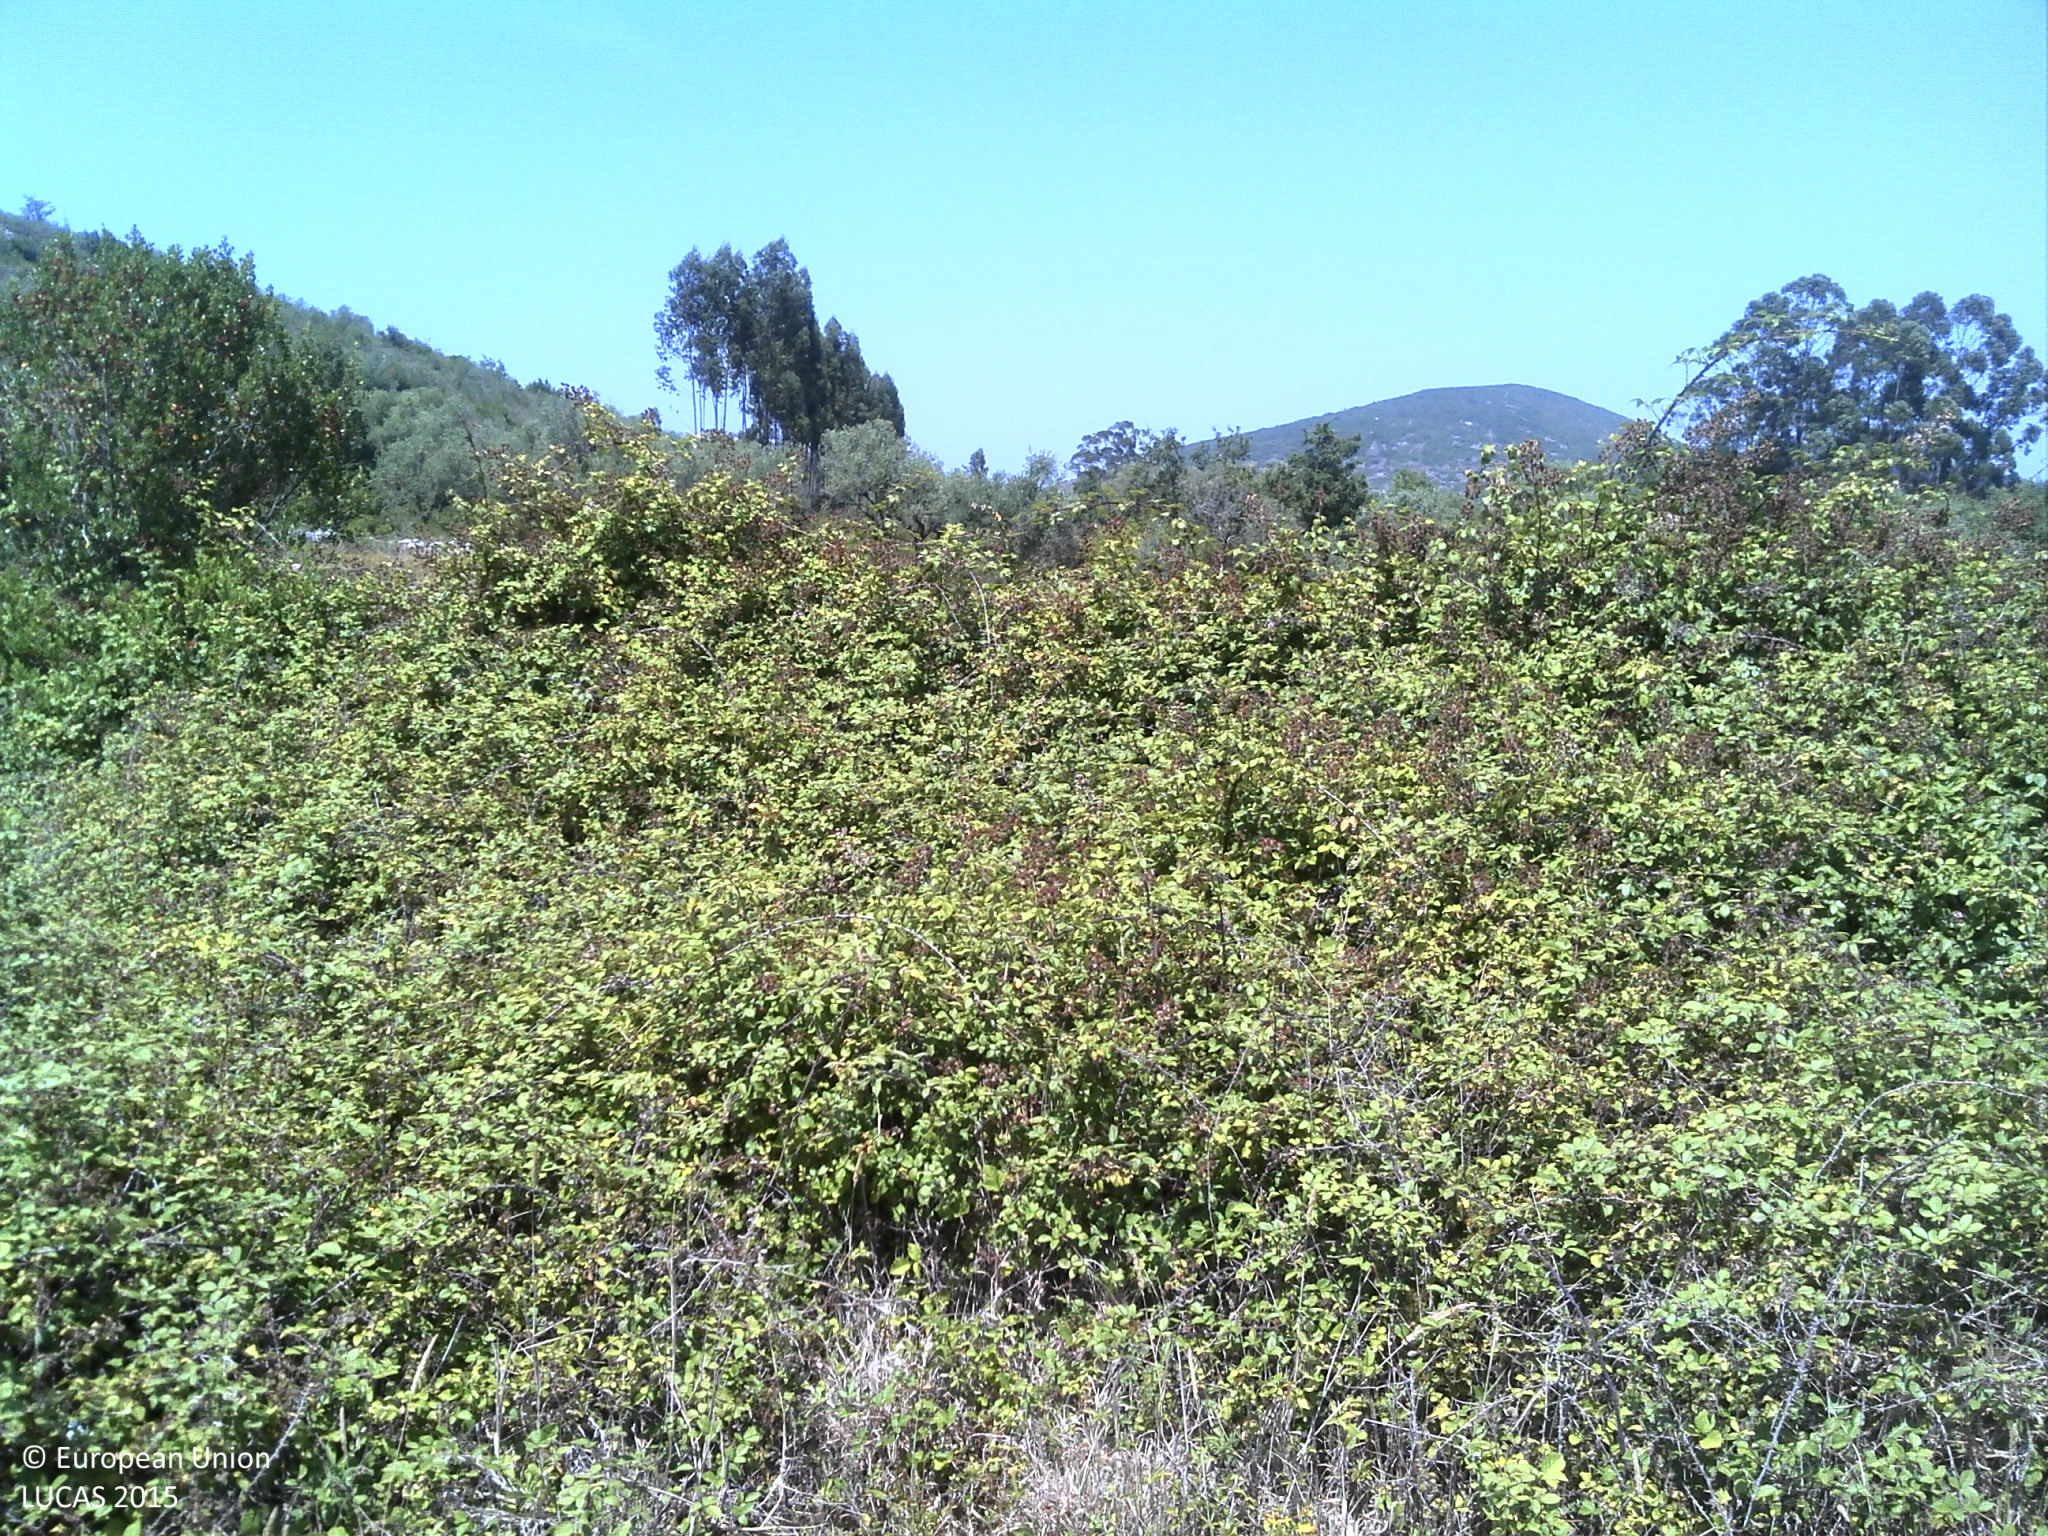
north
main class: Grassland
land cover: Grassland with sparse tree/shrub cover
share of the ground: > 75 %
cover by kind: herbaceous plants 80 %, shrubs 10 %, broadleaved forest trees 5 %, unconsolidated bare surface 5 %
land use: Abandoned areas
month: July
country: PT
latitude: 40.0628
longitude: -8.5014
